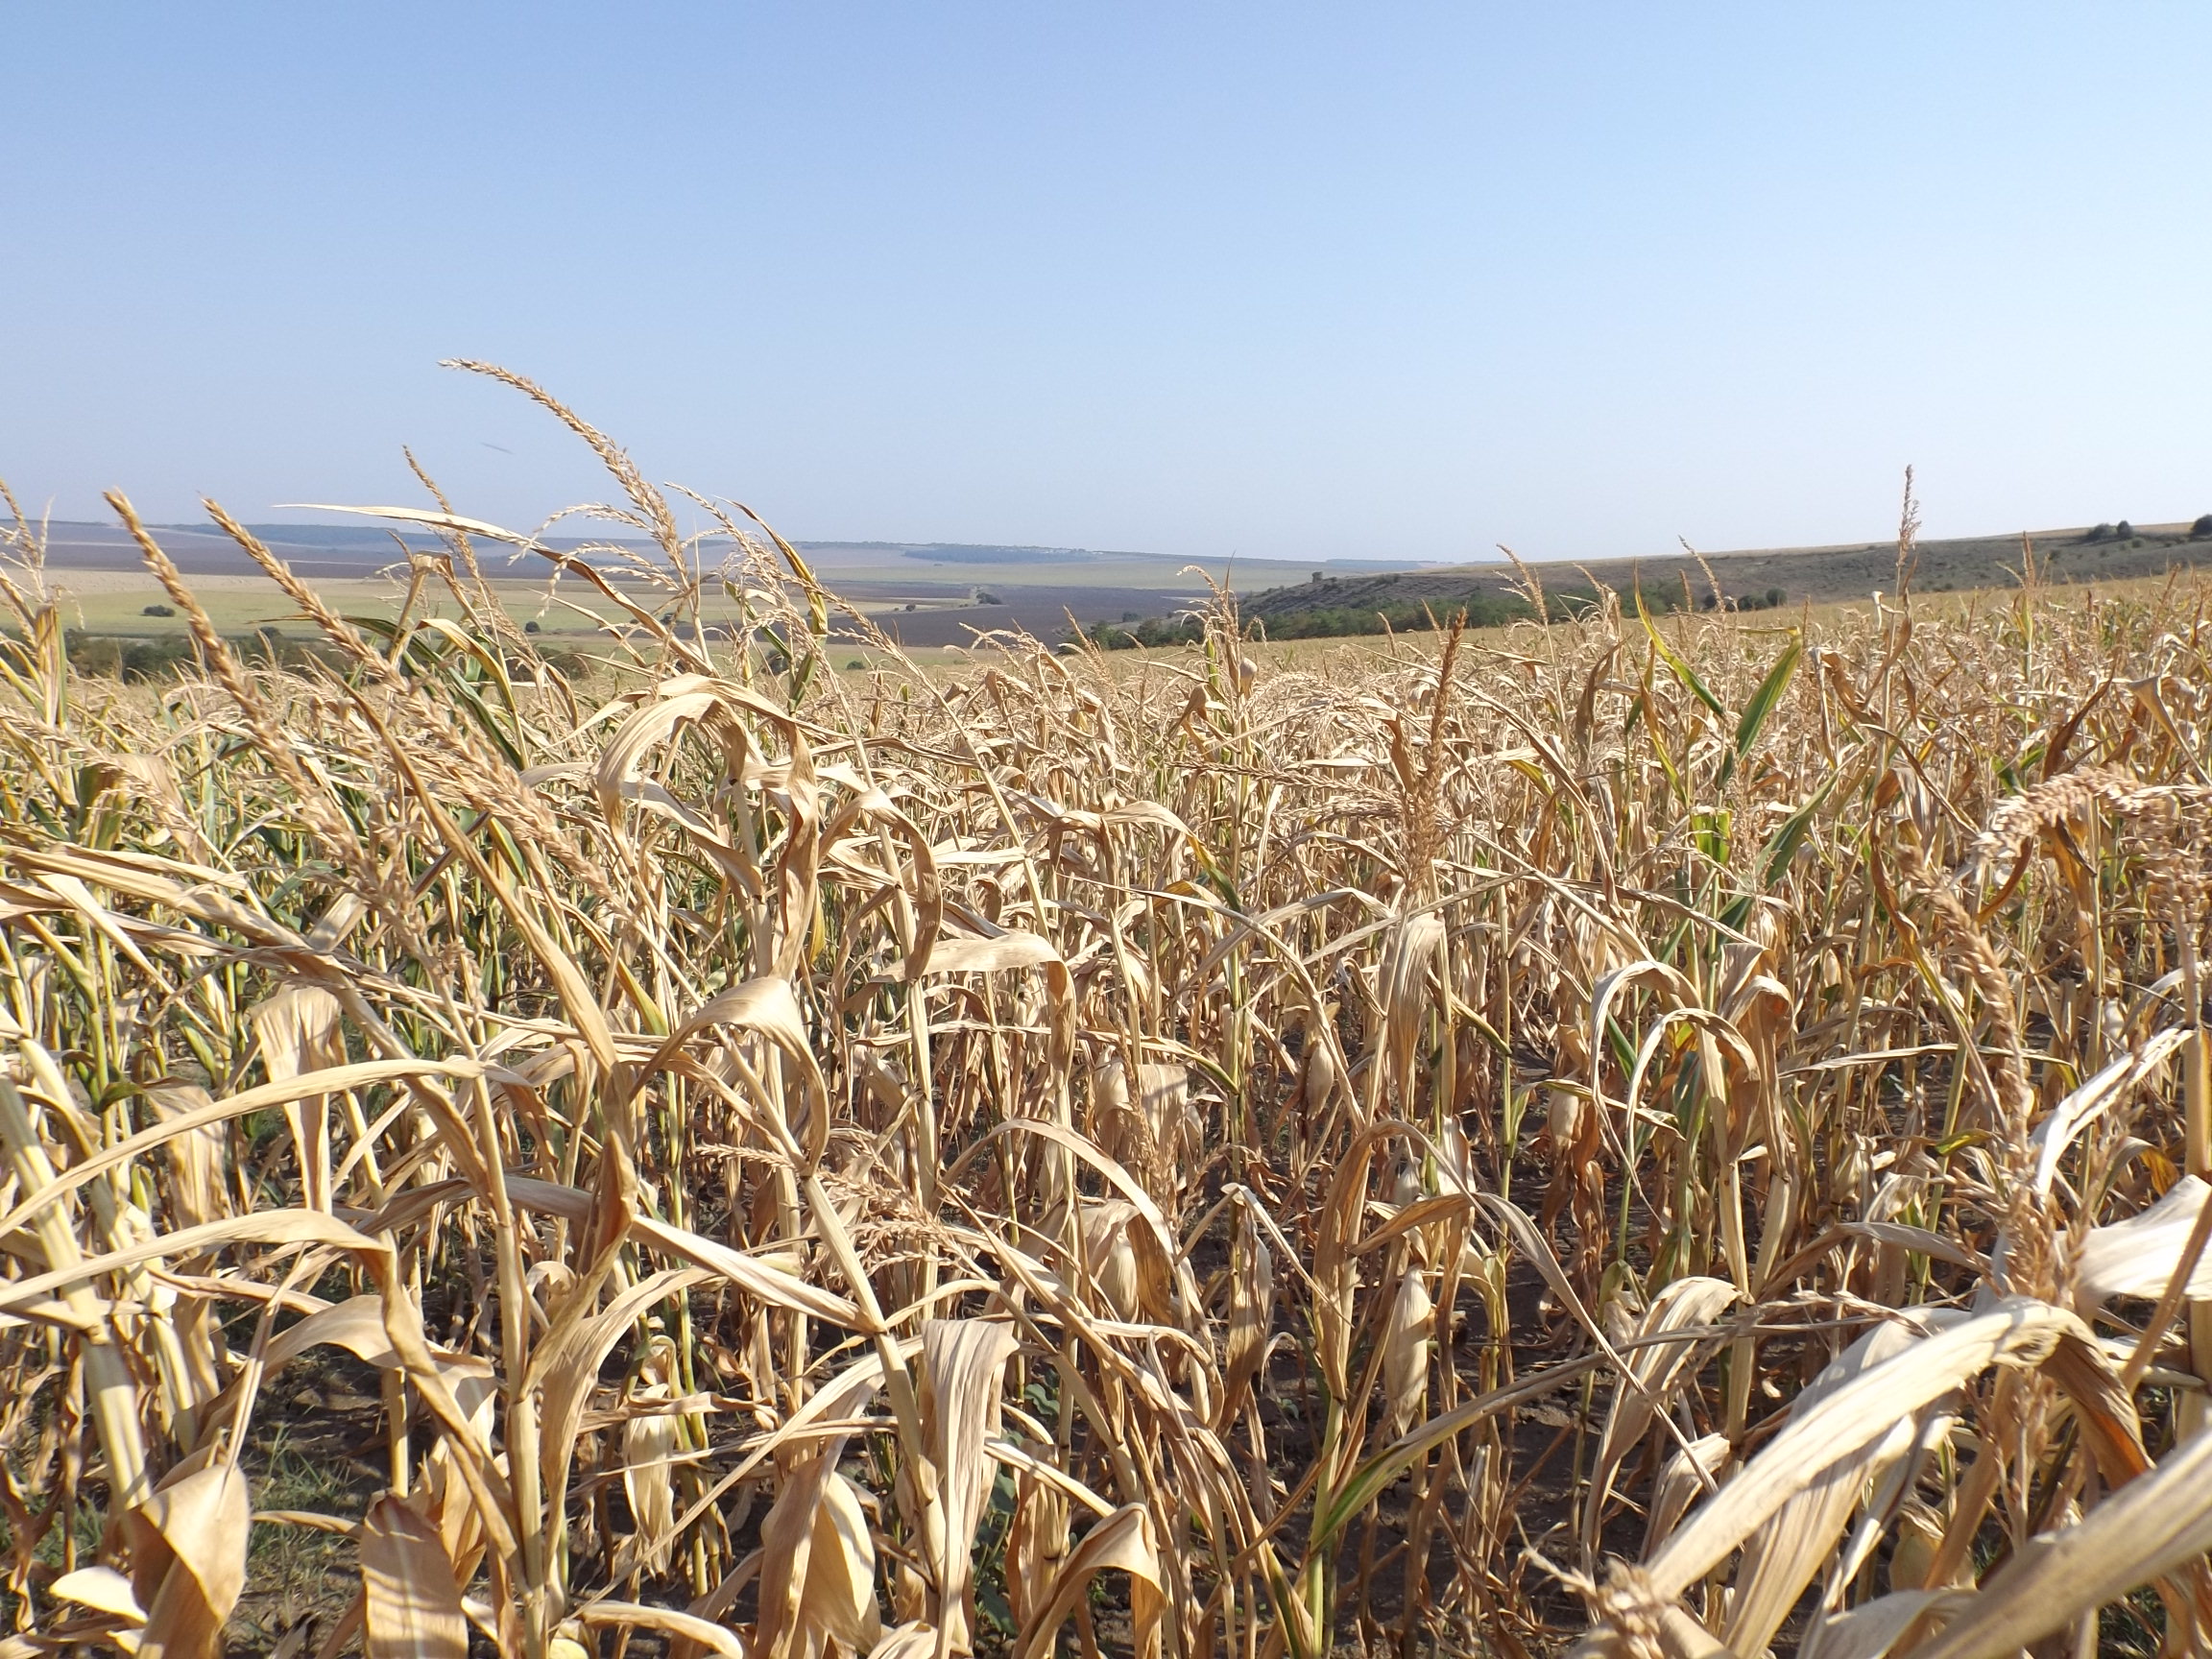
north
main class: Cropland
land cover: Maize
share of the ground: > 75 %
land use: Agriculture (excluding fallow land and kitchen gardens)
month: August
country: BG
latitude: 43.4672
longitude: 27.5483
